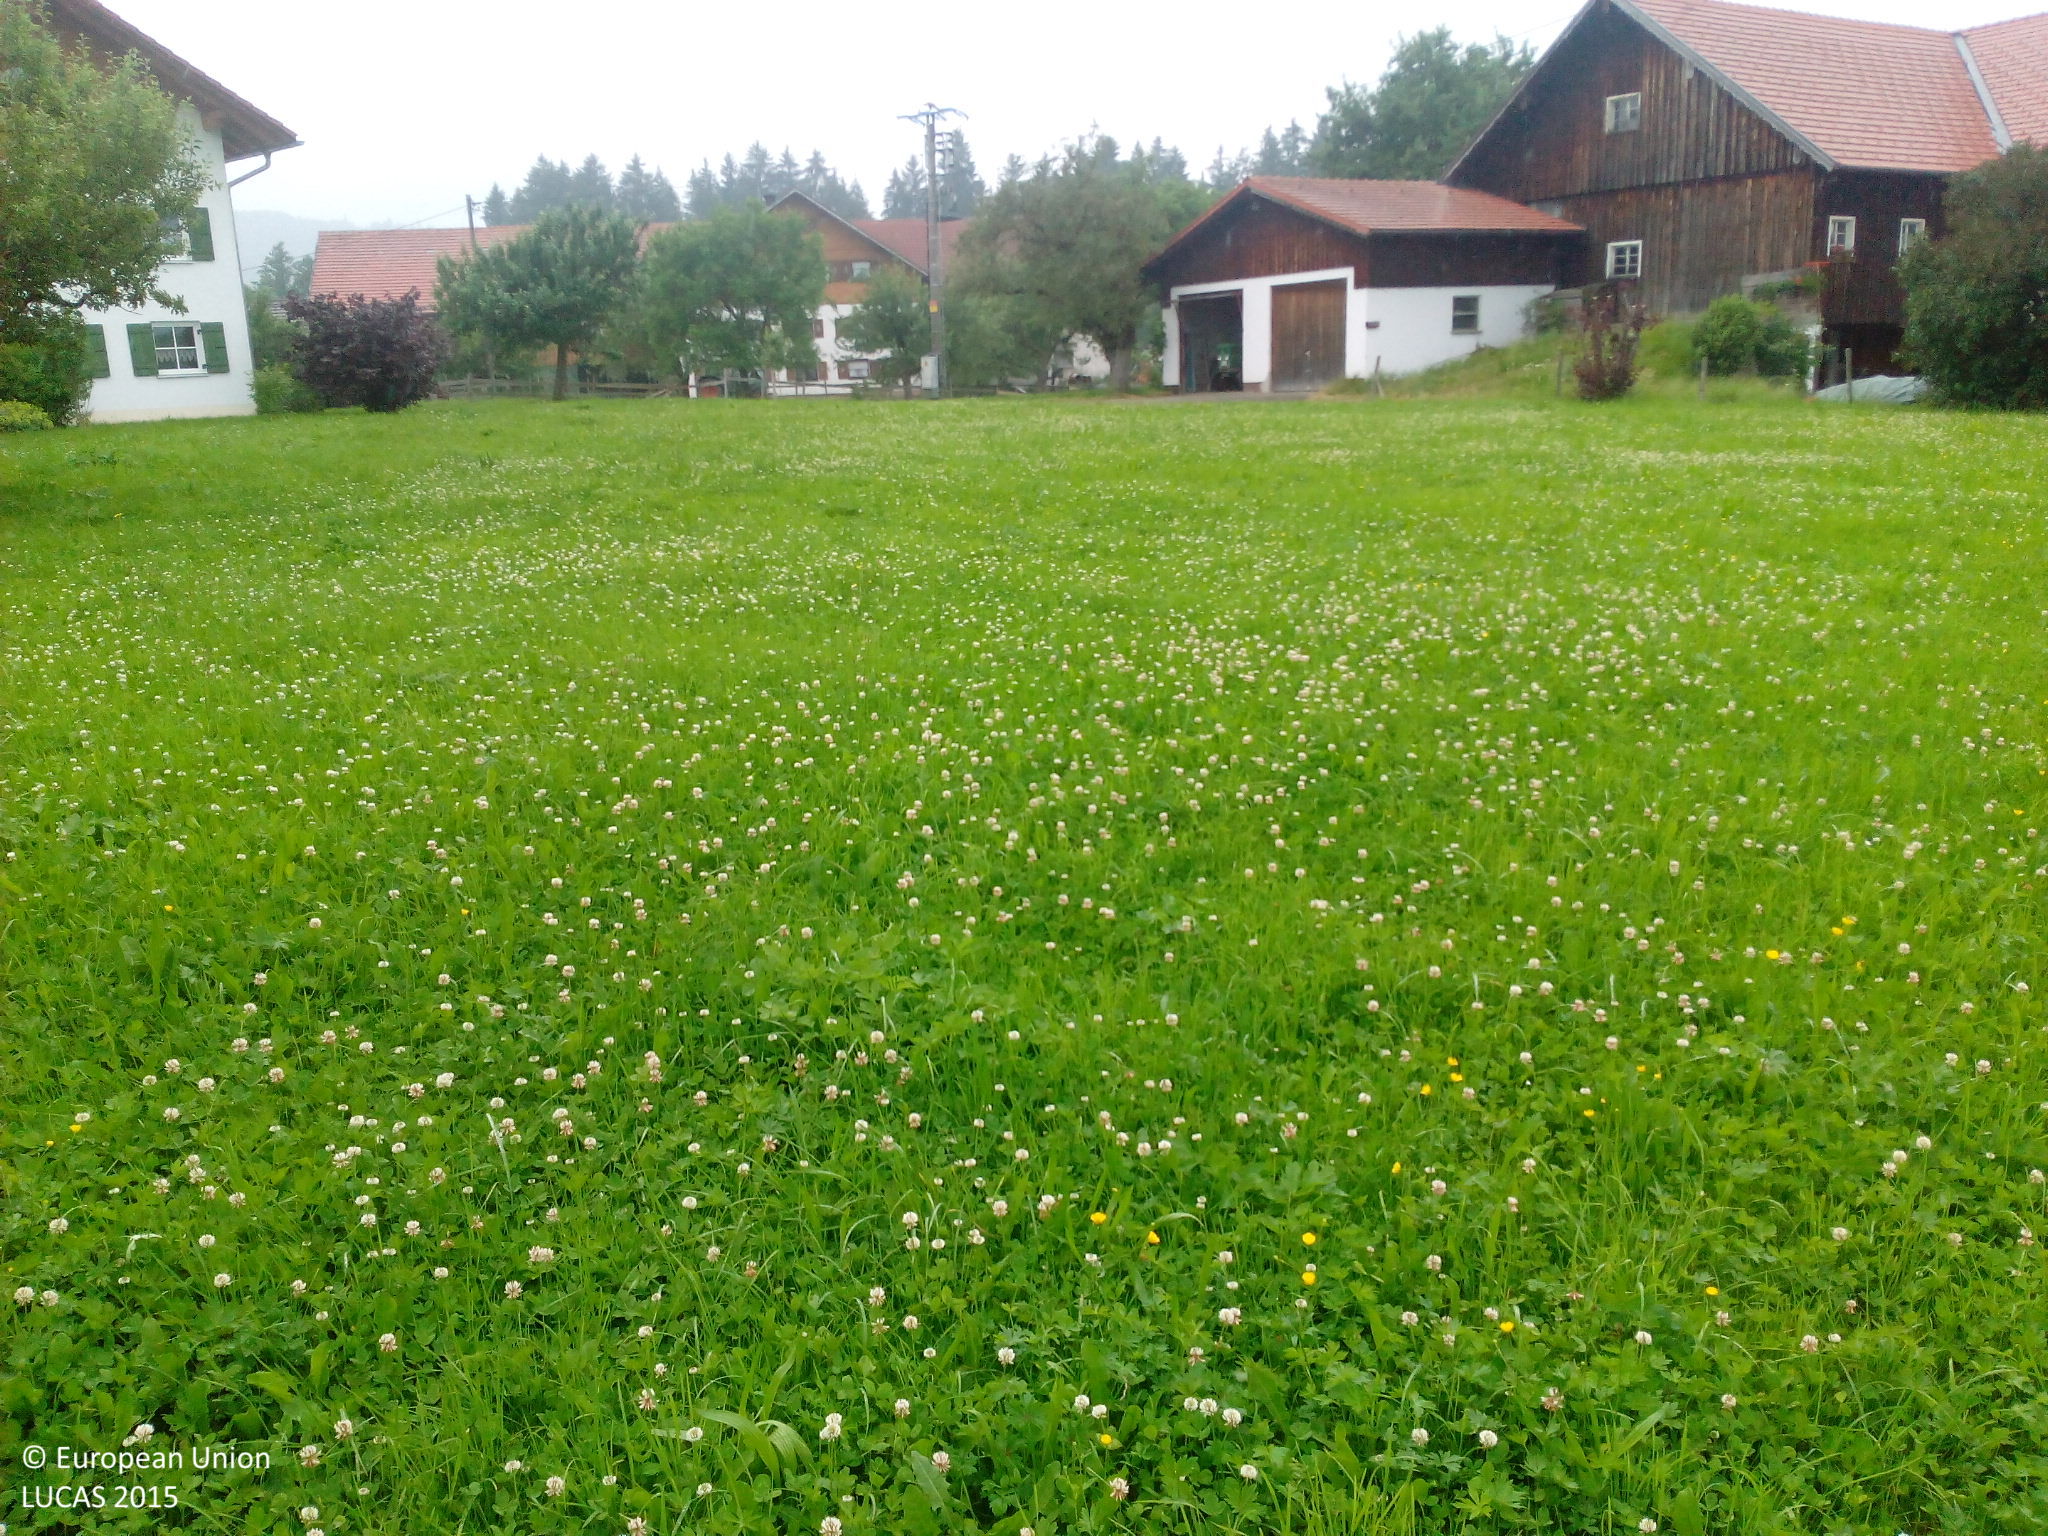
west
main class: Grassland
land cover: Grassland with sparse tree/shrub cover
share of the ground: > 75 %
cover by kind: herbaceous plants 95 %, broadleaved forest trees 5 %
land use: Agriculture (excluding fallow land and kitchen gardens)
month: June
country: DE
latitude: 47.7373
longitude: 10.2532
